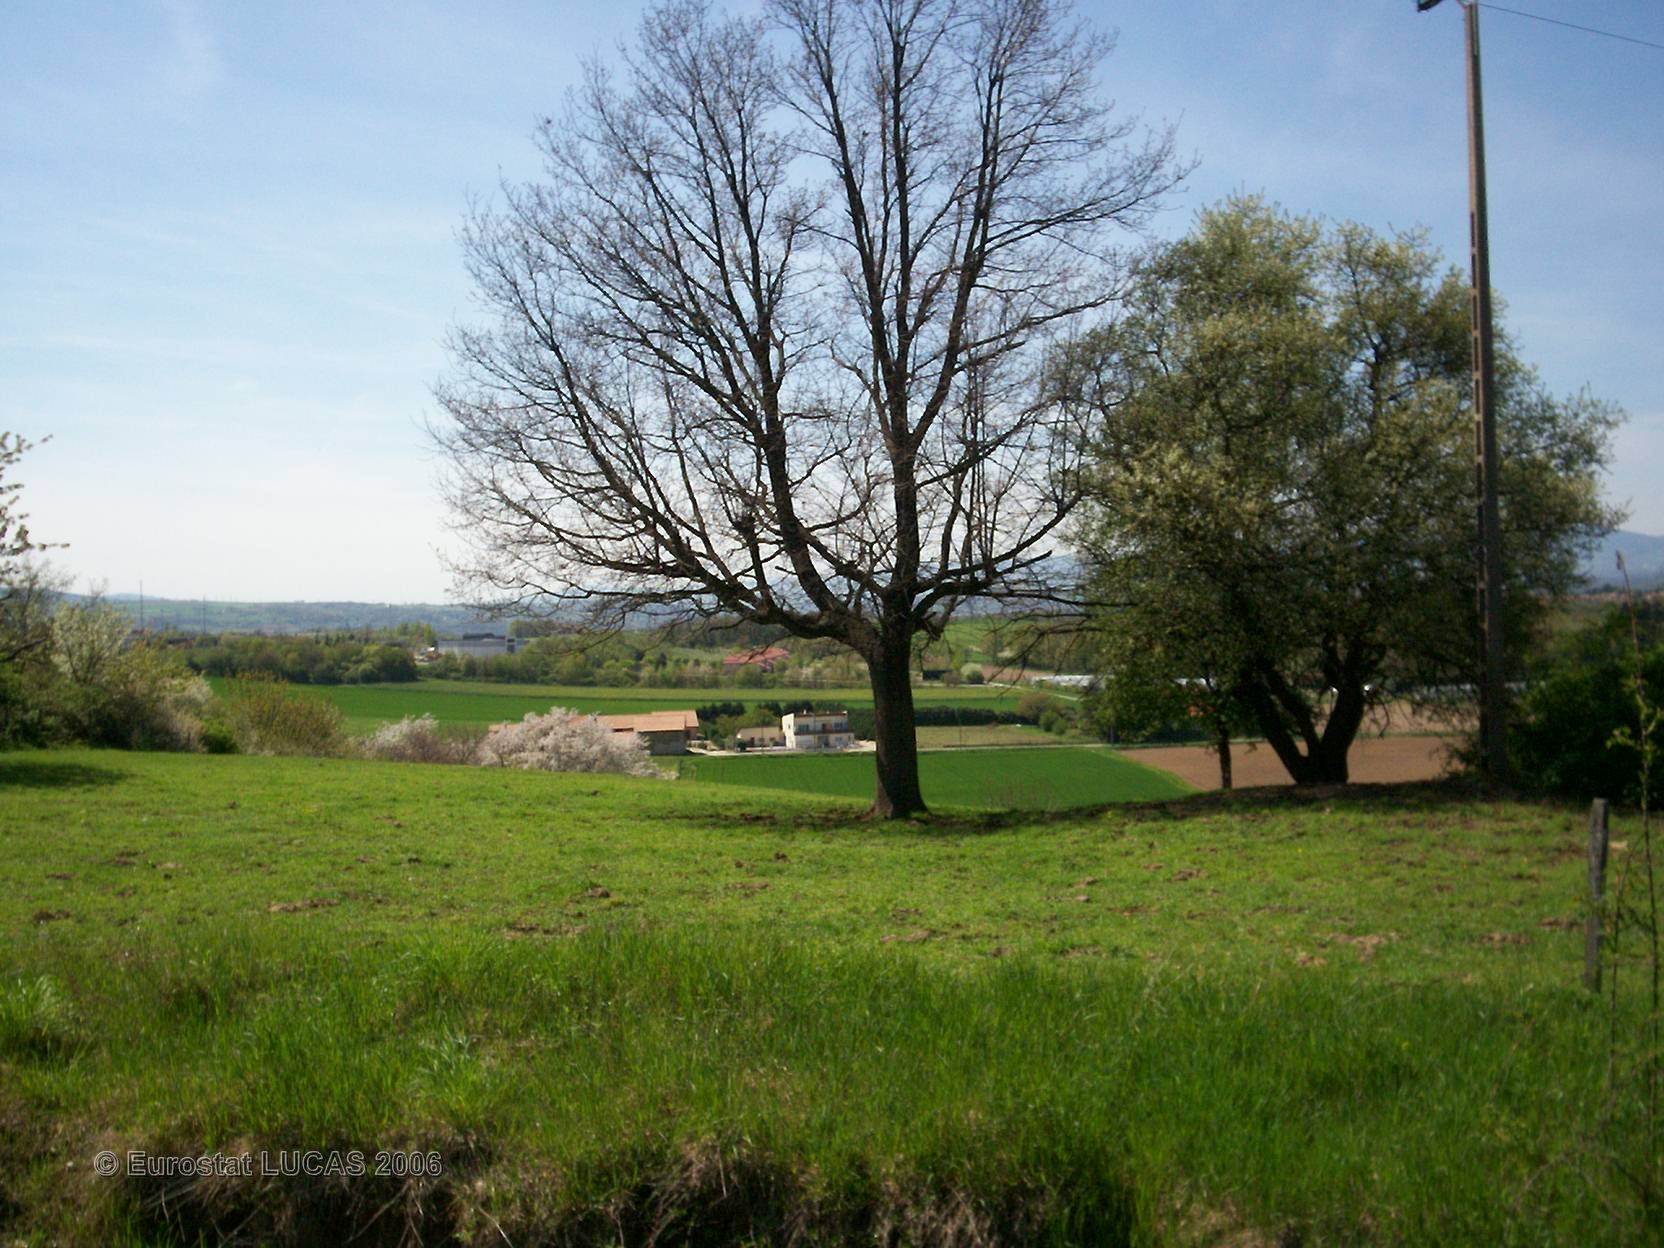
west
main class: Grassland
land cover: Grassland with sparse tree/shrub cover
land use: Agriculture (excluding fallow land and kitchen gardens)
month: April
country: FR
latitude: 45.5948
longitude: 4.8378
